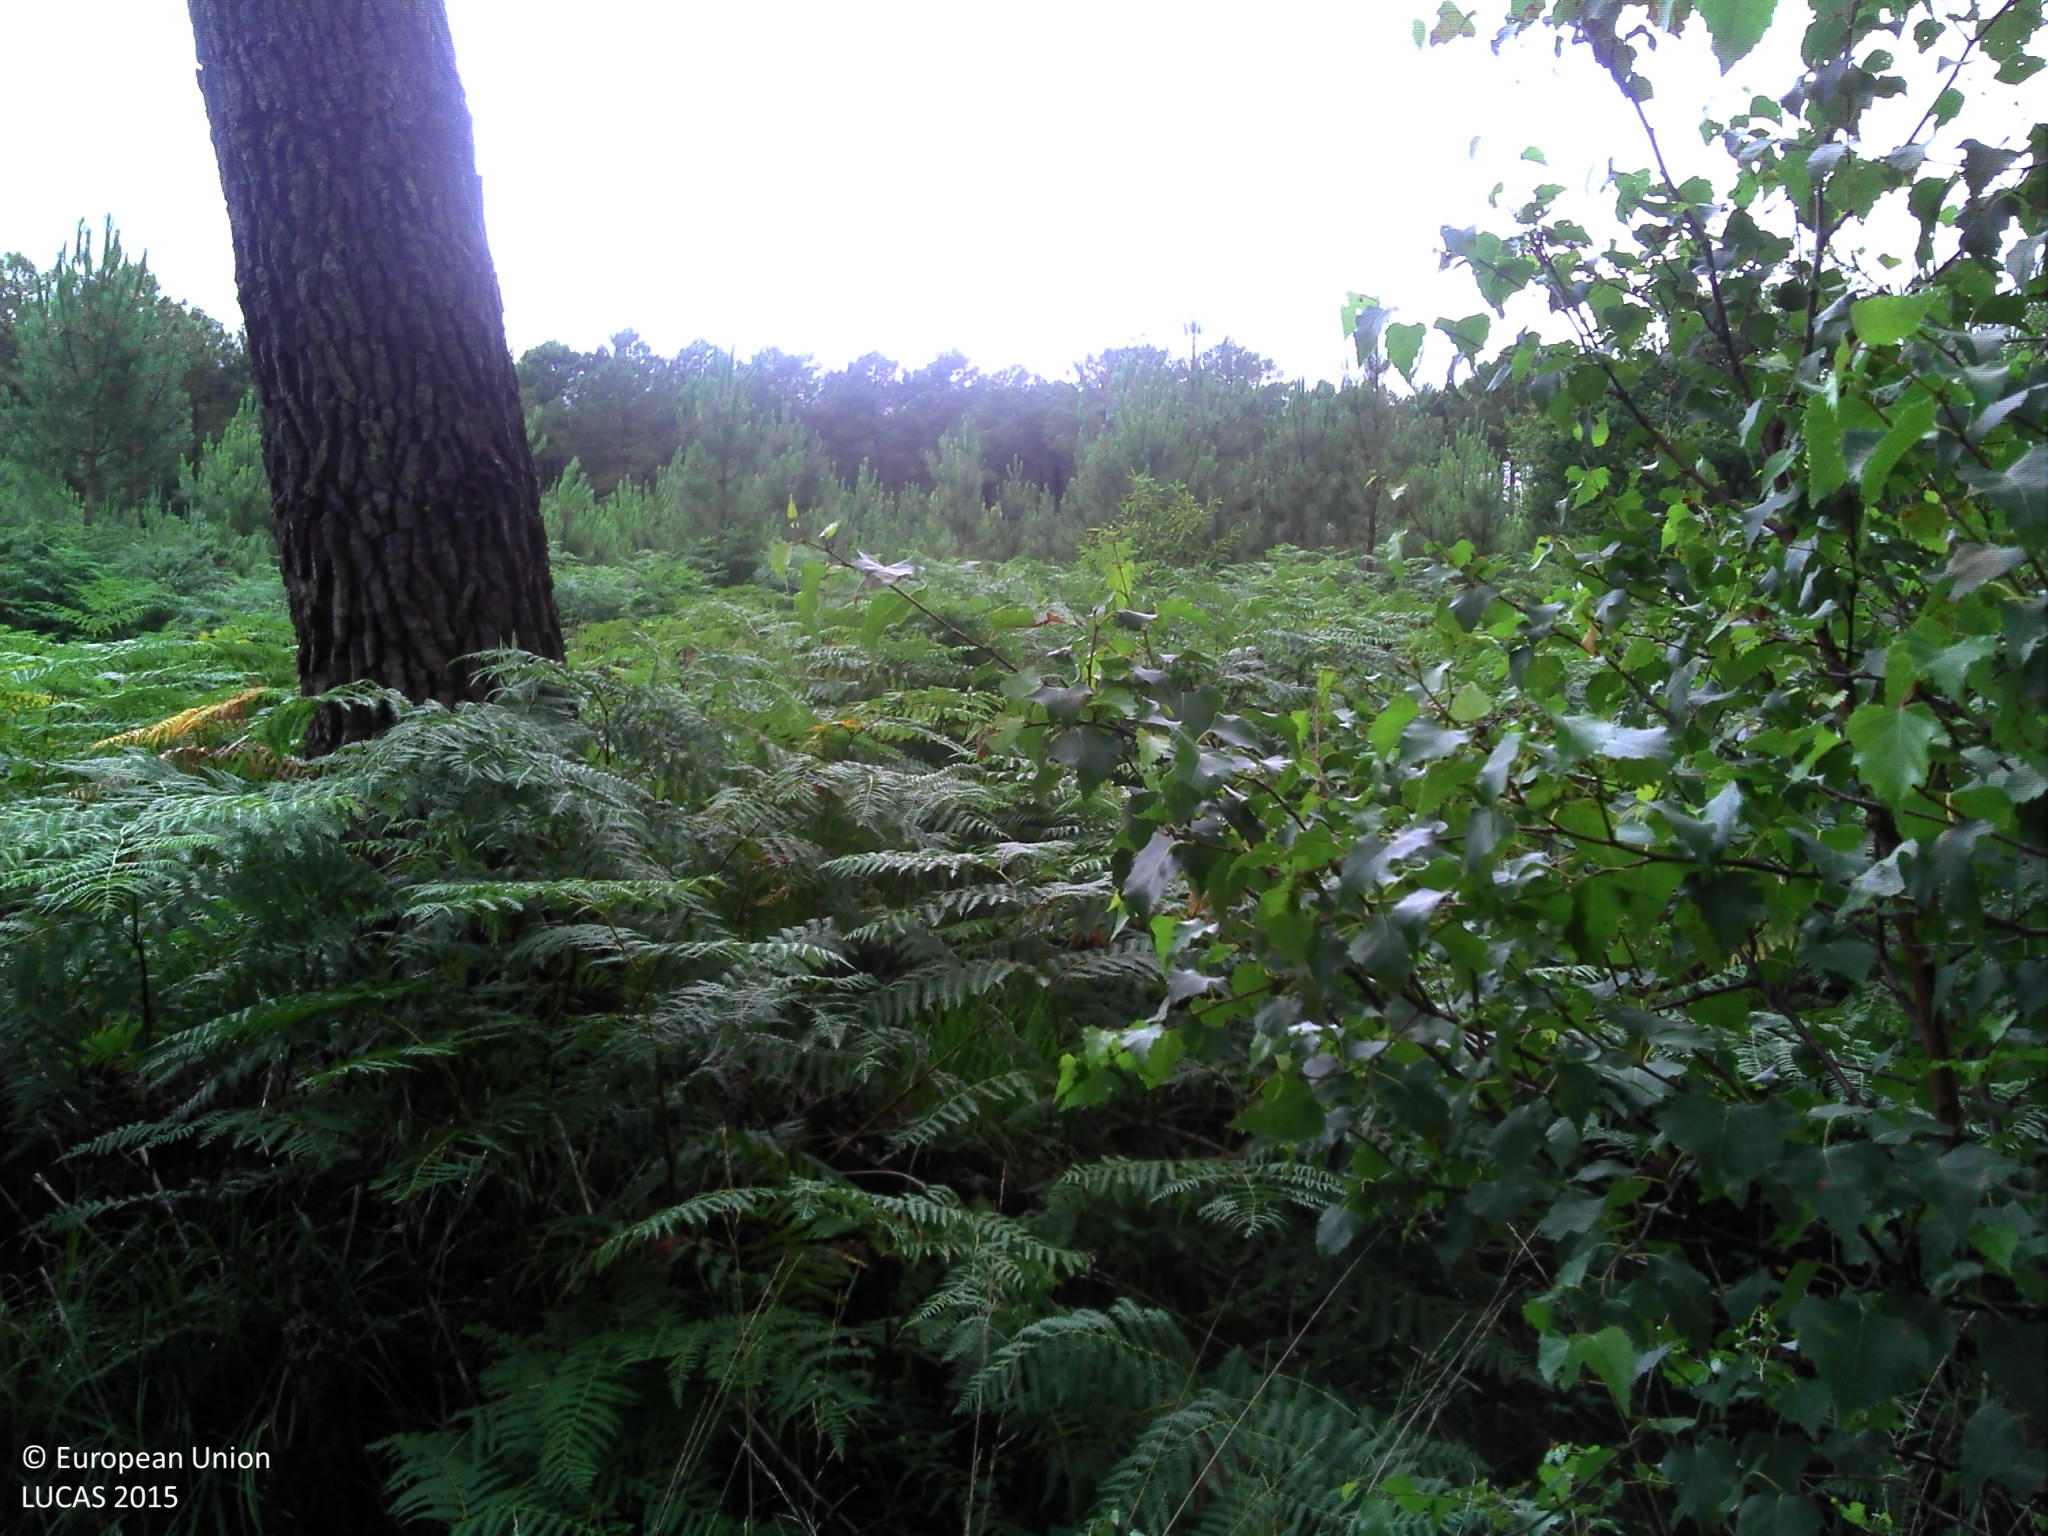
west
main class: Woodland
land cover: Pine dominated coniferous woodland
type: exotic forest
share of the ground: > 75 %
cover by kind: coniferous forest trees 95 %, herbaceous plants 5 %
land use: Forestry
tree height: > 5 m
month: July
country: FR
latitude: 47.5089
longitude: -1.8512
